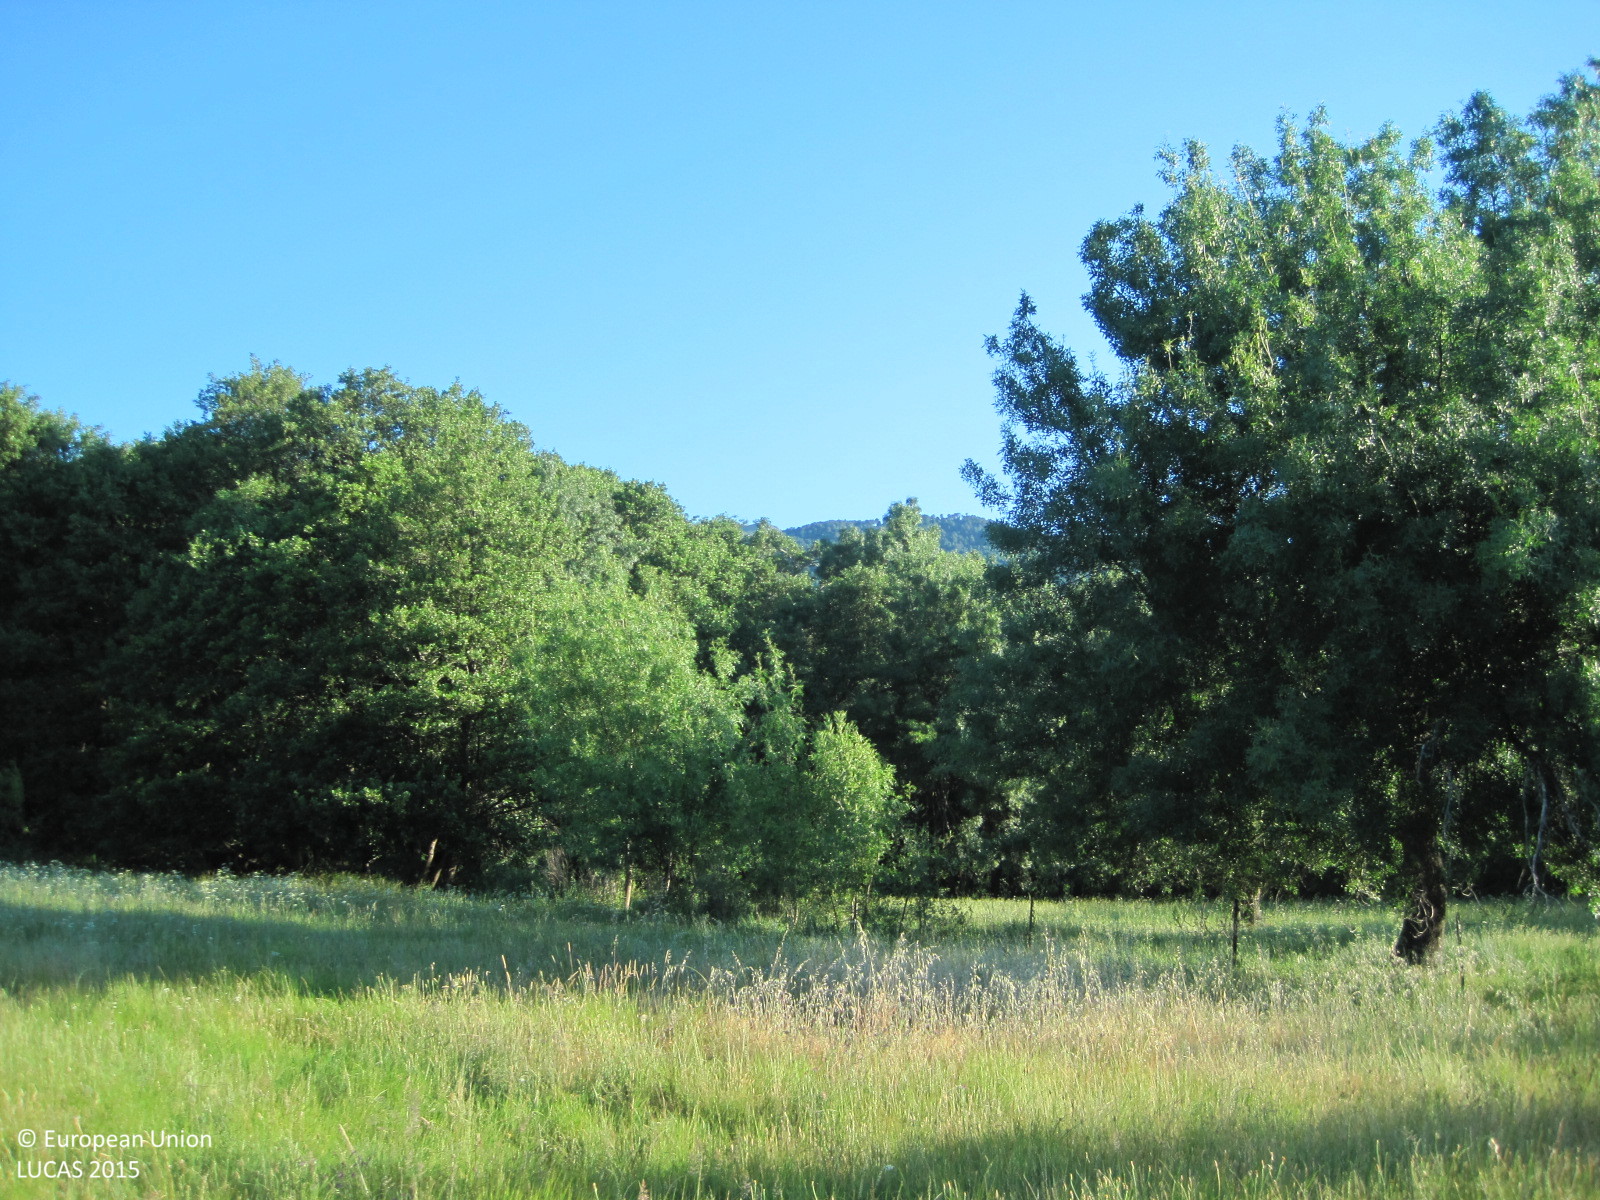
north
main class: Grassland
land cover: Grassland without tree/shrub cover
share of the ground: > 75 %
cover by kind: herbaceous plants 100 %
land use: Agriculture (excluding fallow land and kitchen gardens)
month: May
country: ES
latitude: 40.2990
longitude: -4.7694
